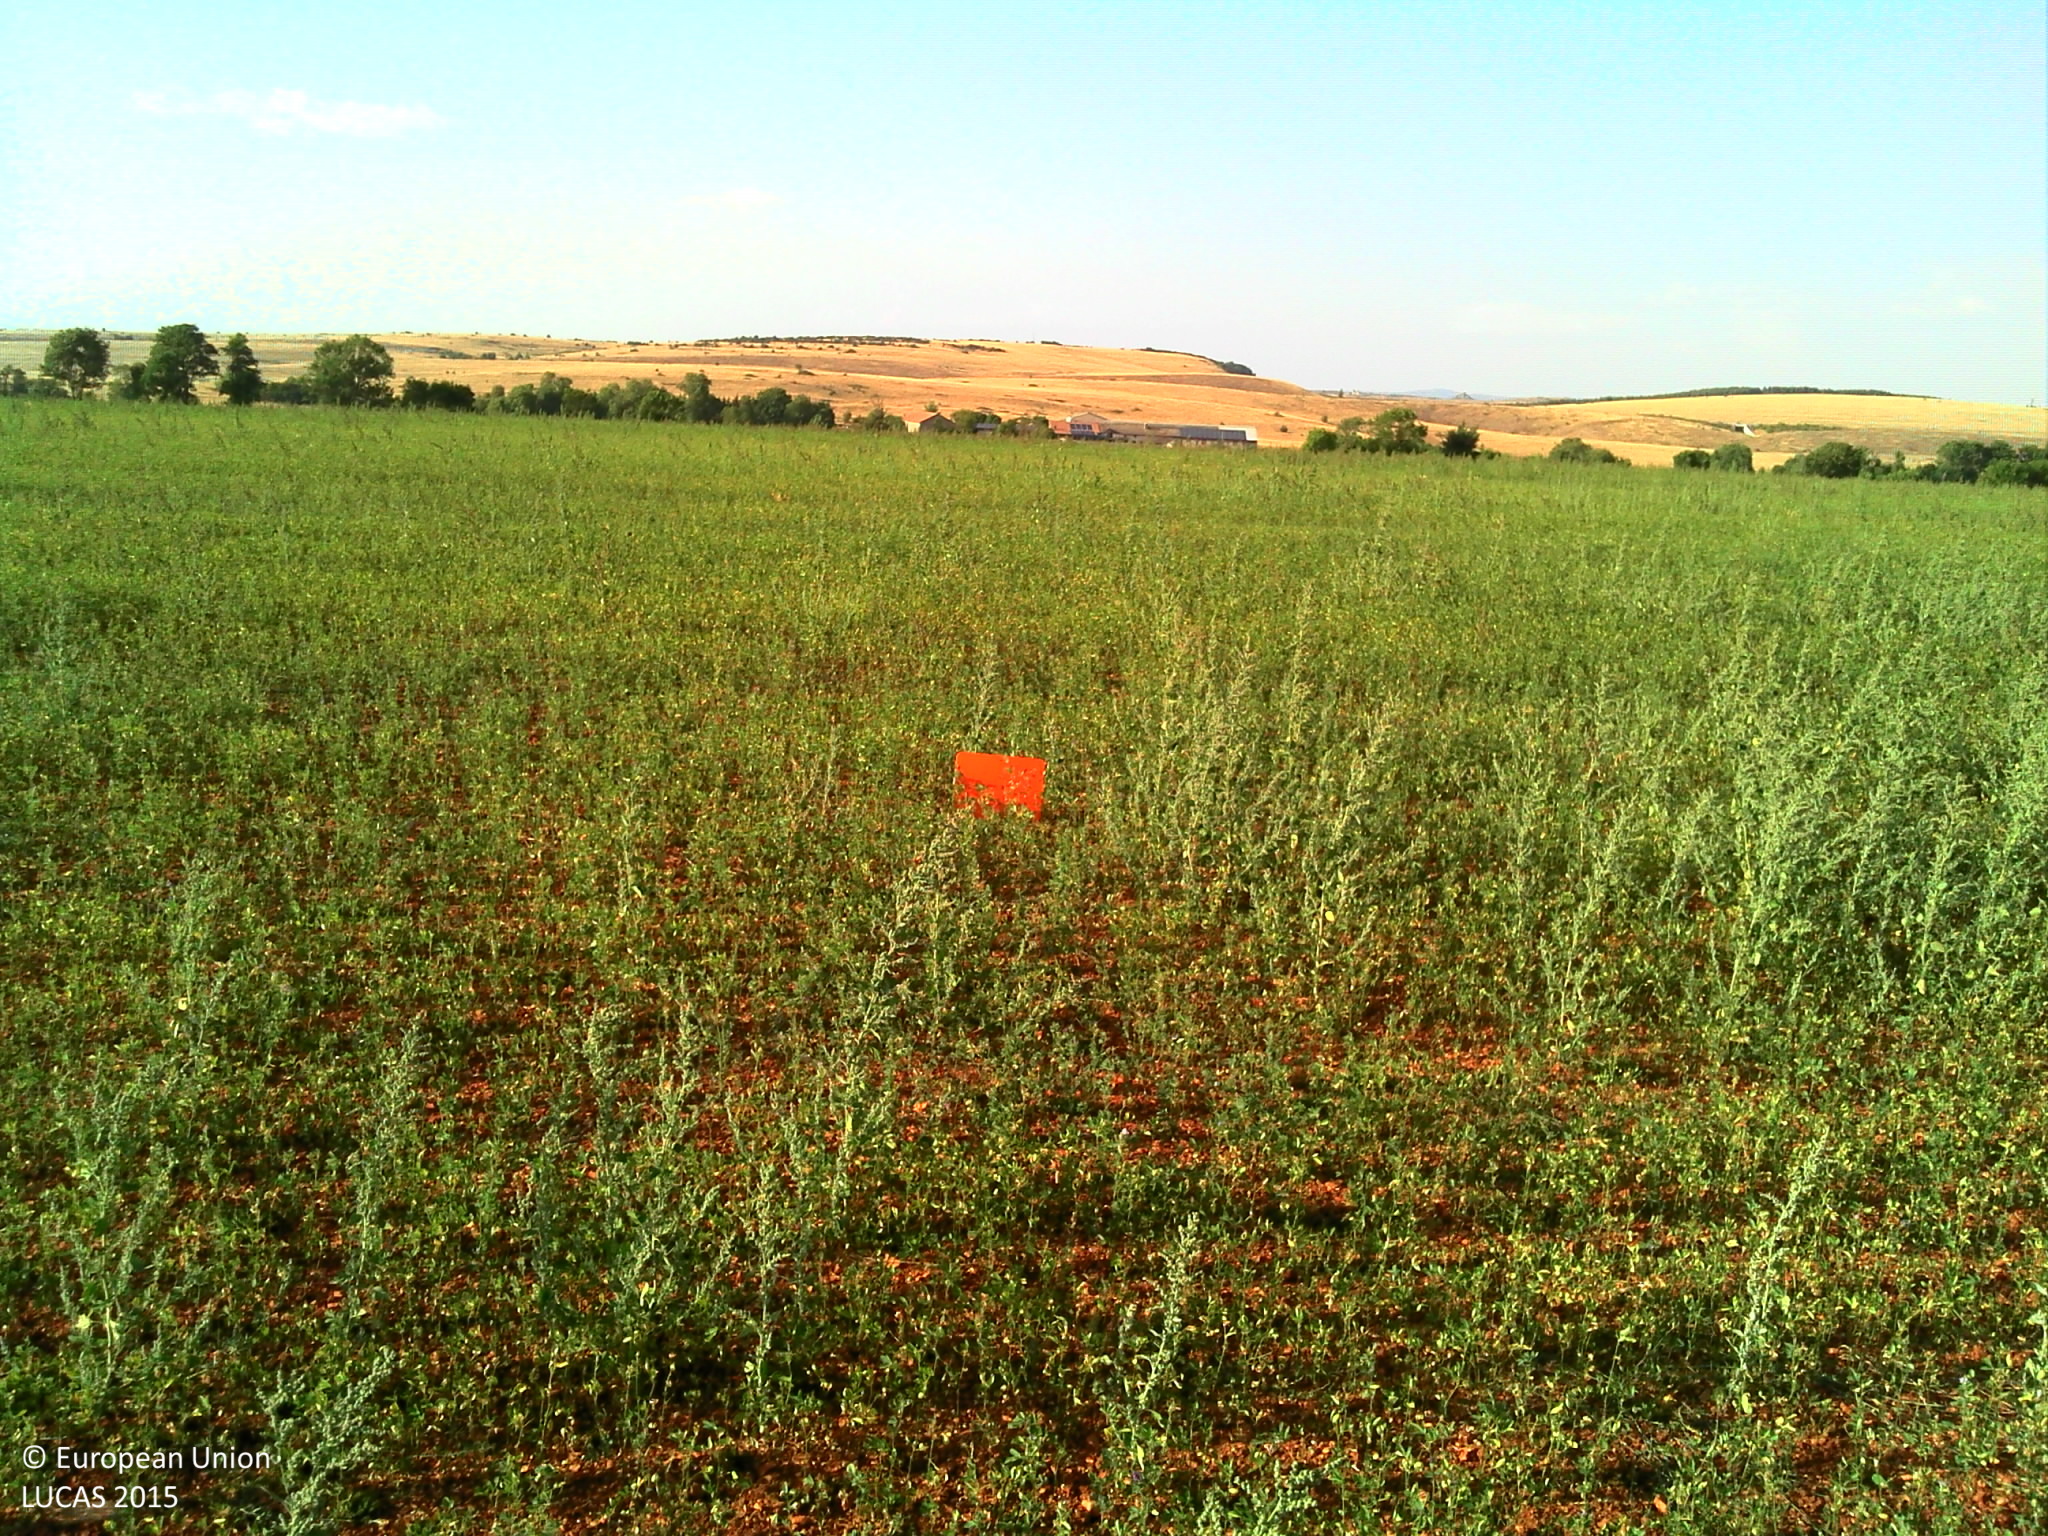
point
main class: Cropland
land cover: Lucerne
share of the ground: 50 - 75 %
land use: Agriculture (excluding fallow land and kitchen gardens)
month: August
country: FR
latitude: 44.0127
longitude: 3.1084
